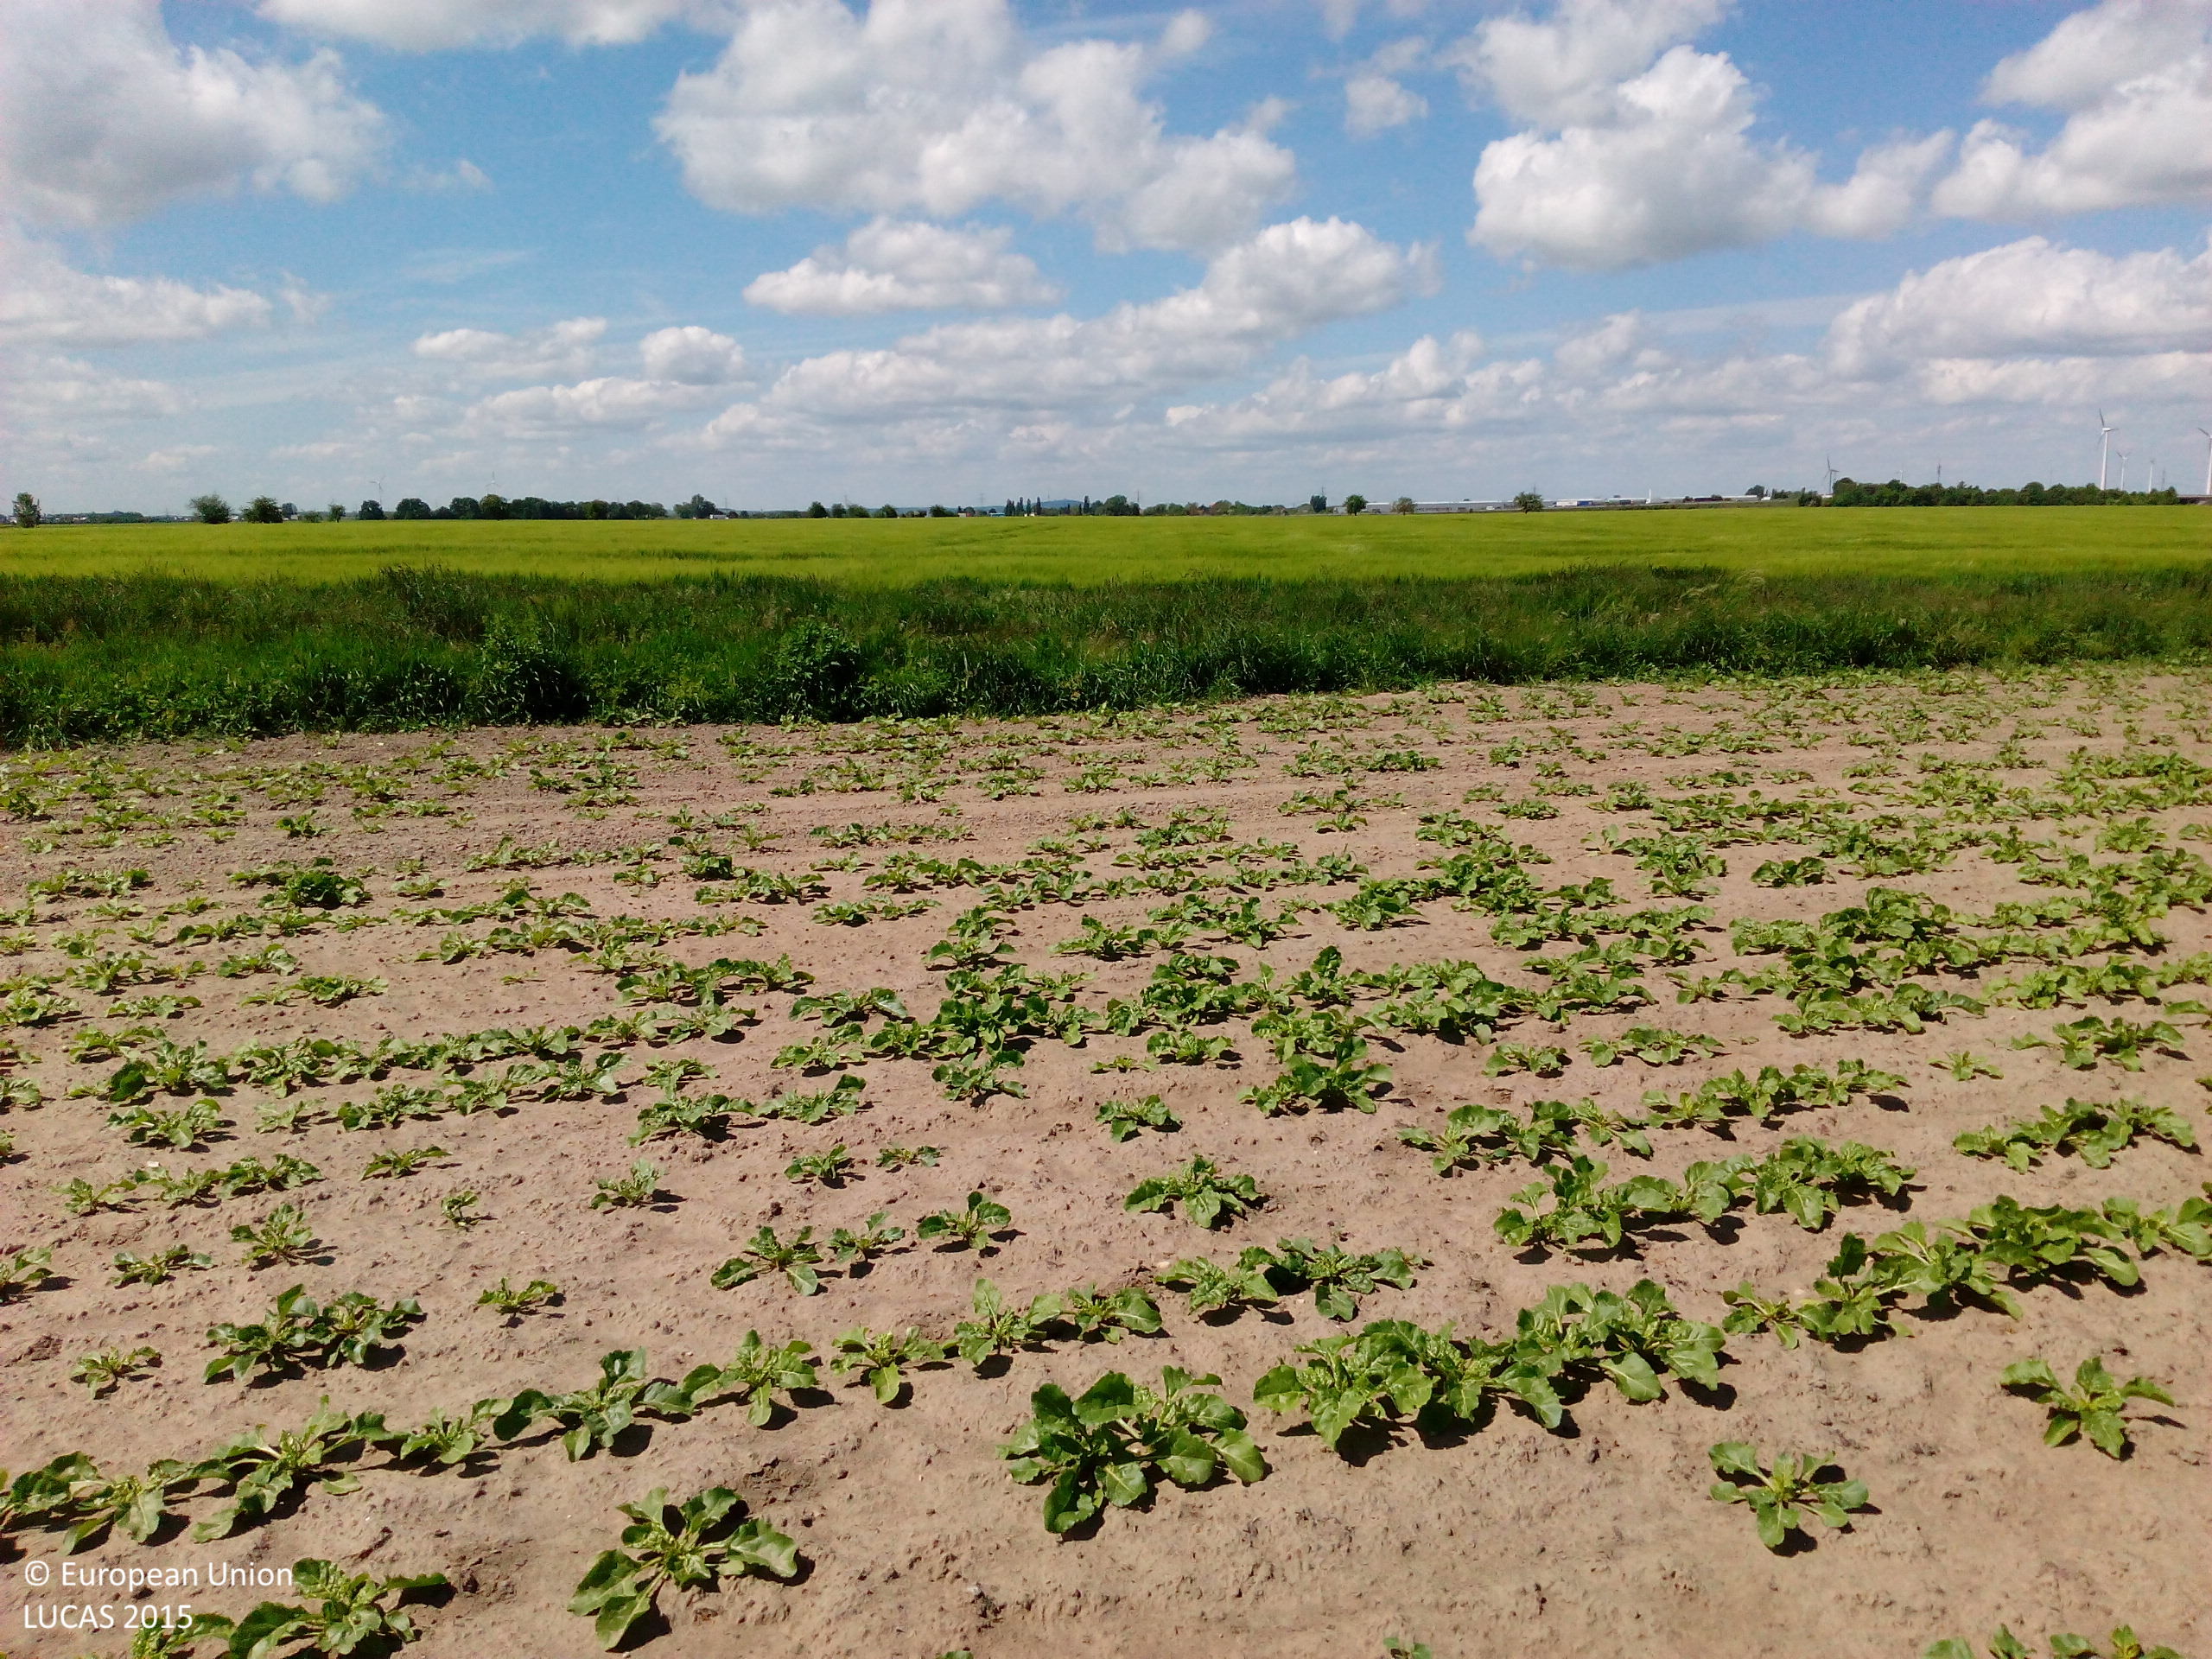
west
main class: Cropland
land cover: Sugar beet
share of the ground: 50 - 75 %
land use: Agriculture (excluding fallow land and kitchen gardens)
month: May
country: DE
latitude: 51.6197
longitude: 12.2095
